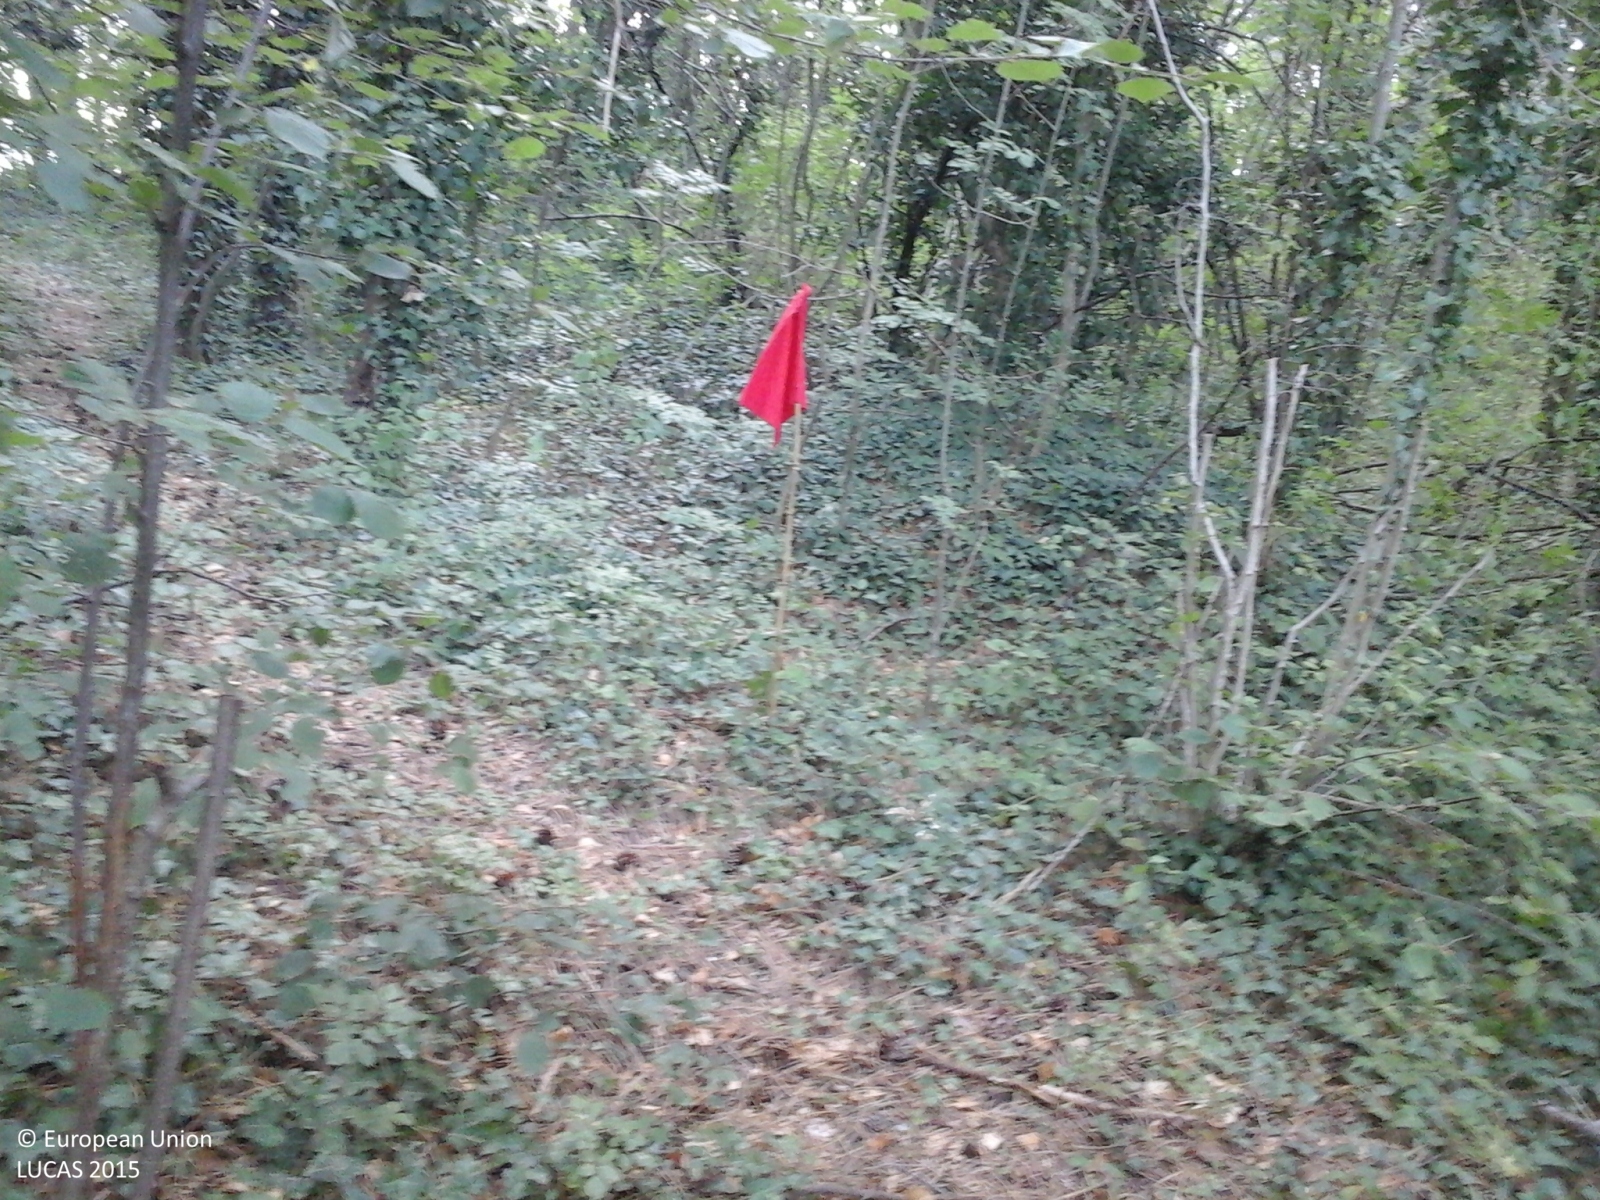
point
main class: Woodland
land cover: Broadleaved woodland
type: thermophilous deciduous forest
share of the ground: > 75 %
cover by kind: broadleaved forest trees 80 %, coniferous forest trees 20 %
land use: Forestry
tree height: > 5 m
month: July
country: IT
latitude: 45.4977
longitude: 11.1881
